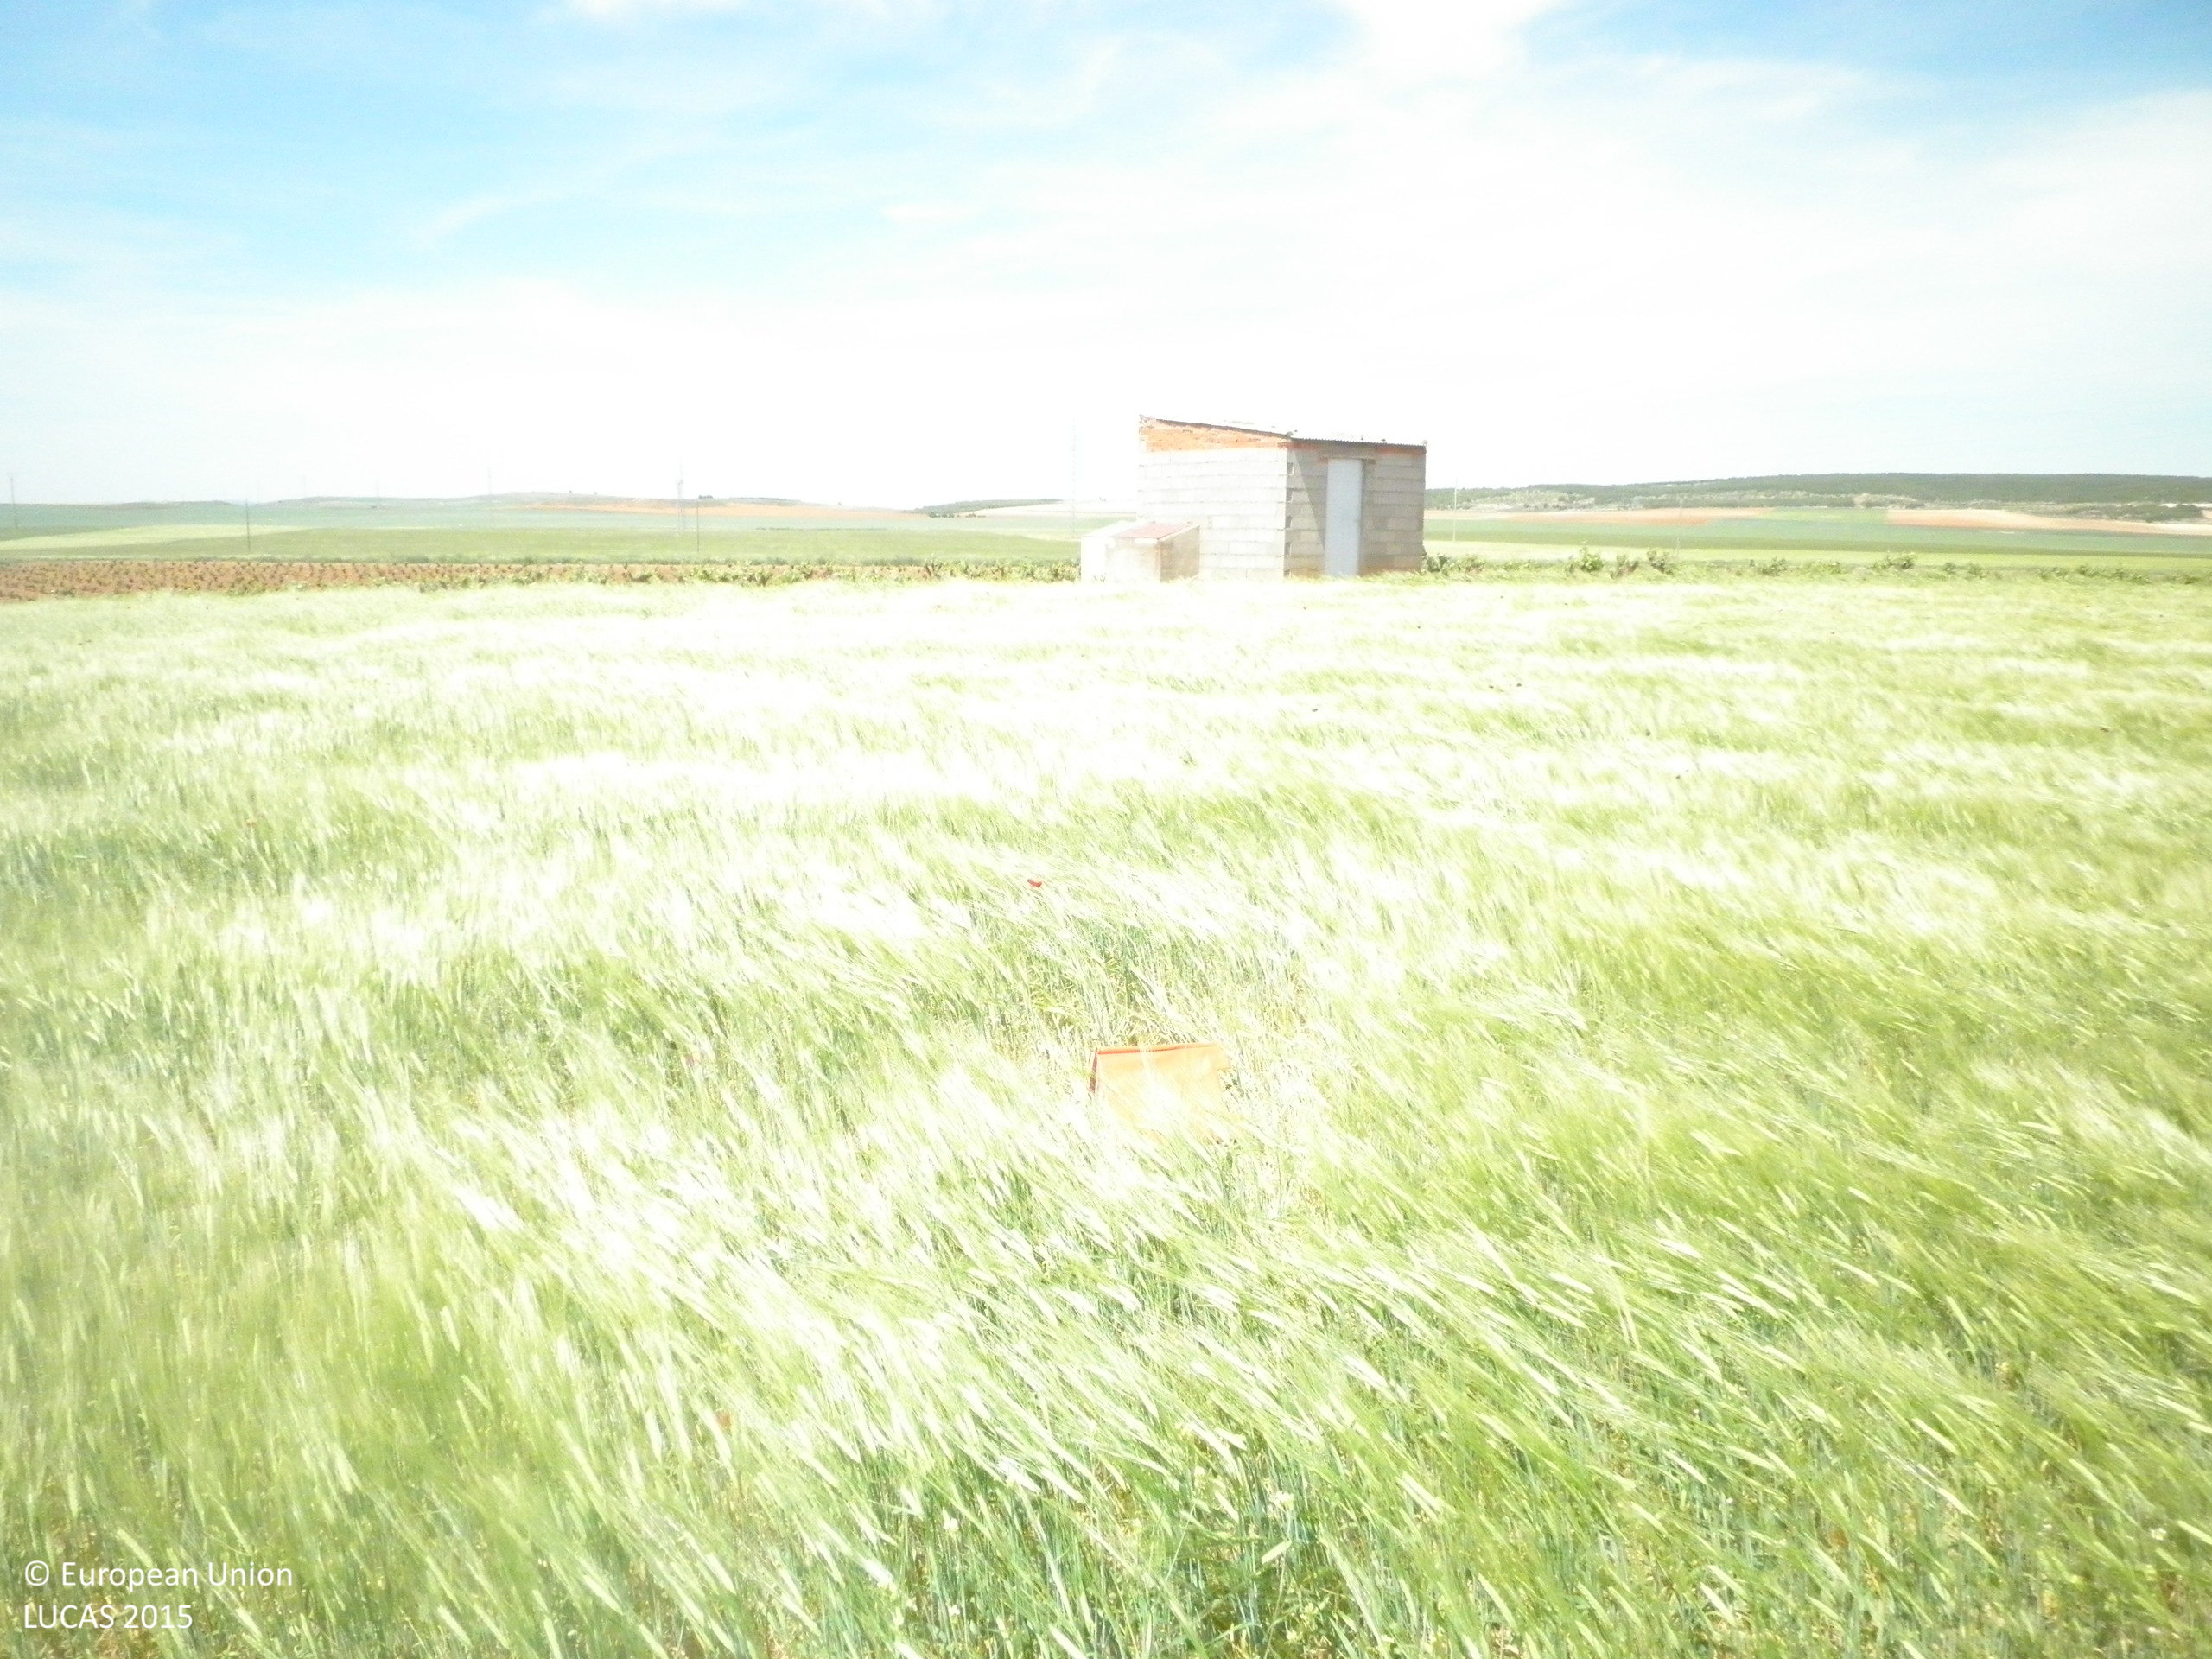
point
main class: Cropland
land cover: Barley
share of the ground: > 75 %
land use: Agriculture (excluding fallow land and kitchen gardens)
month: May
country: ES
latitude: 39.5616
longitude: -2.7368
